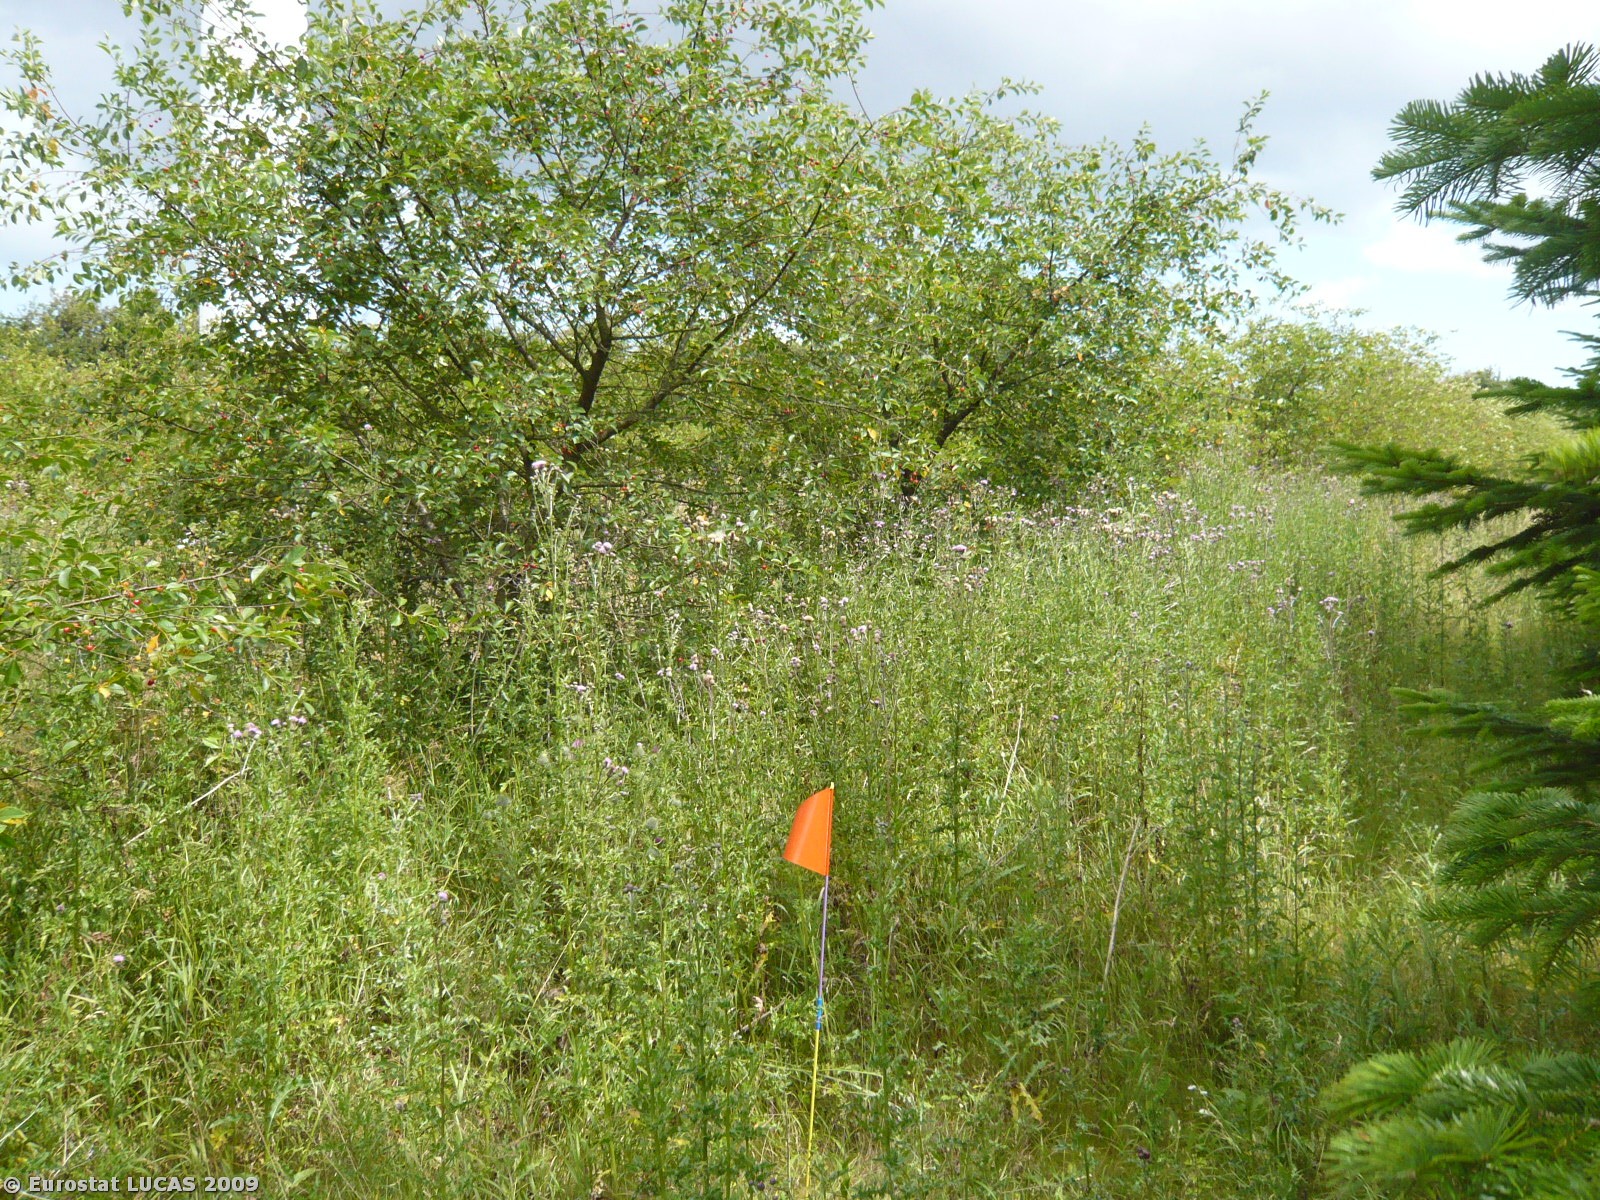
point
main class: Cropland
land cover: Cherry fruit
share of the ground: > 75 %
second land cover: Spontaneously vegetated surfaces
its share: 10 - 25 %
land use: Agriculture (excluding fallow land and kitchen gardens)
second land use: Fallow land
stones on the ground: < 10 %
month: July
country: DK
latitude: 55.4851
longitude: 10.6482
